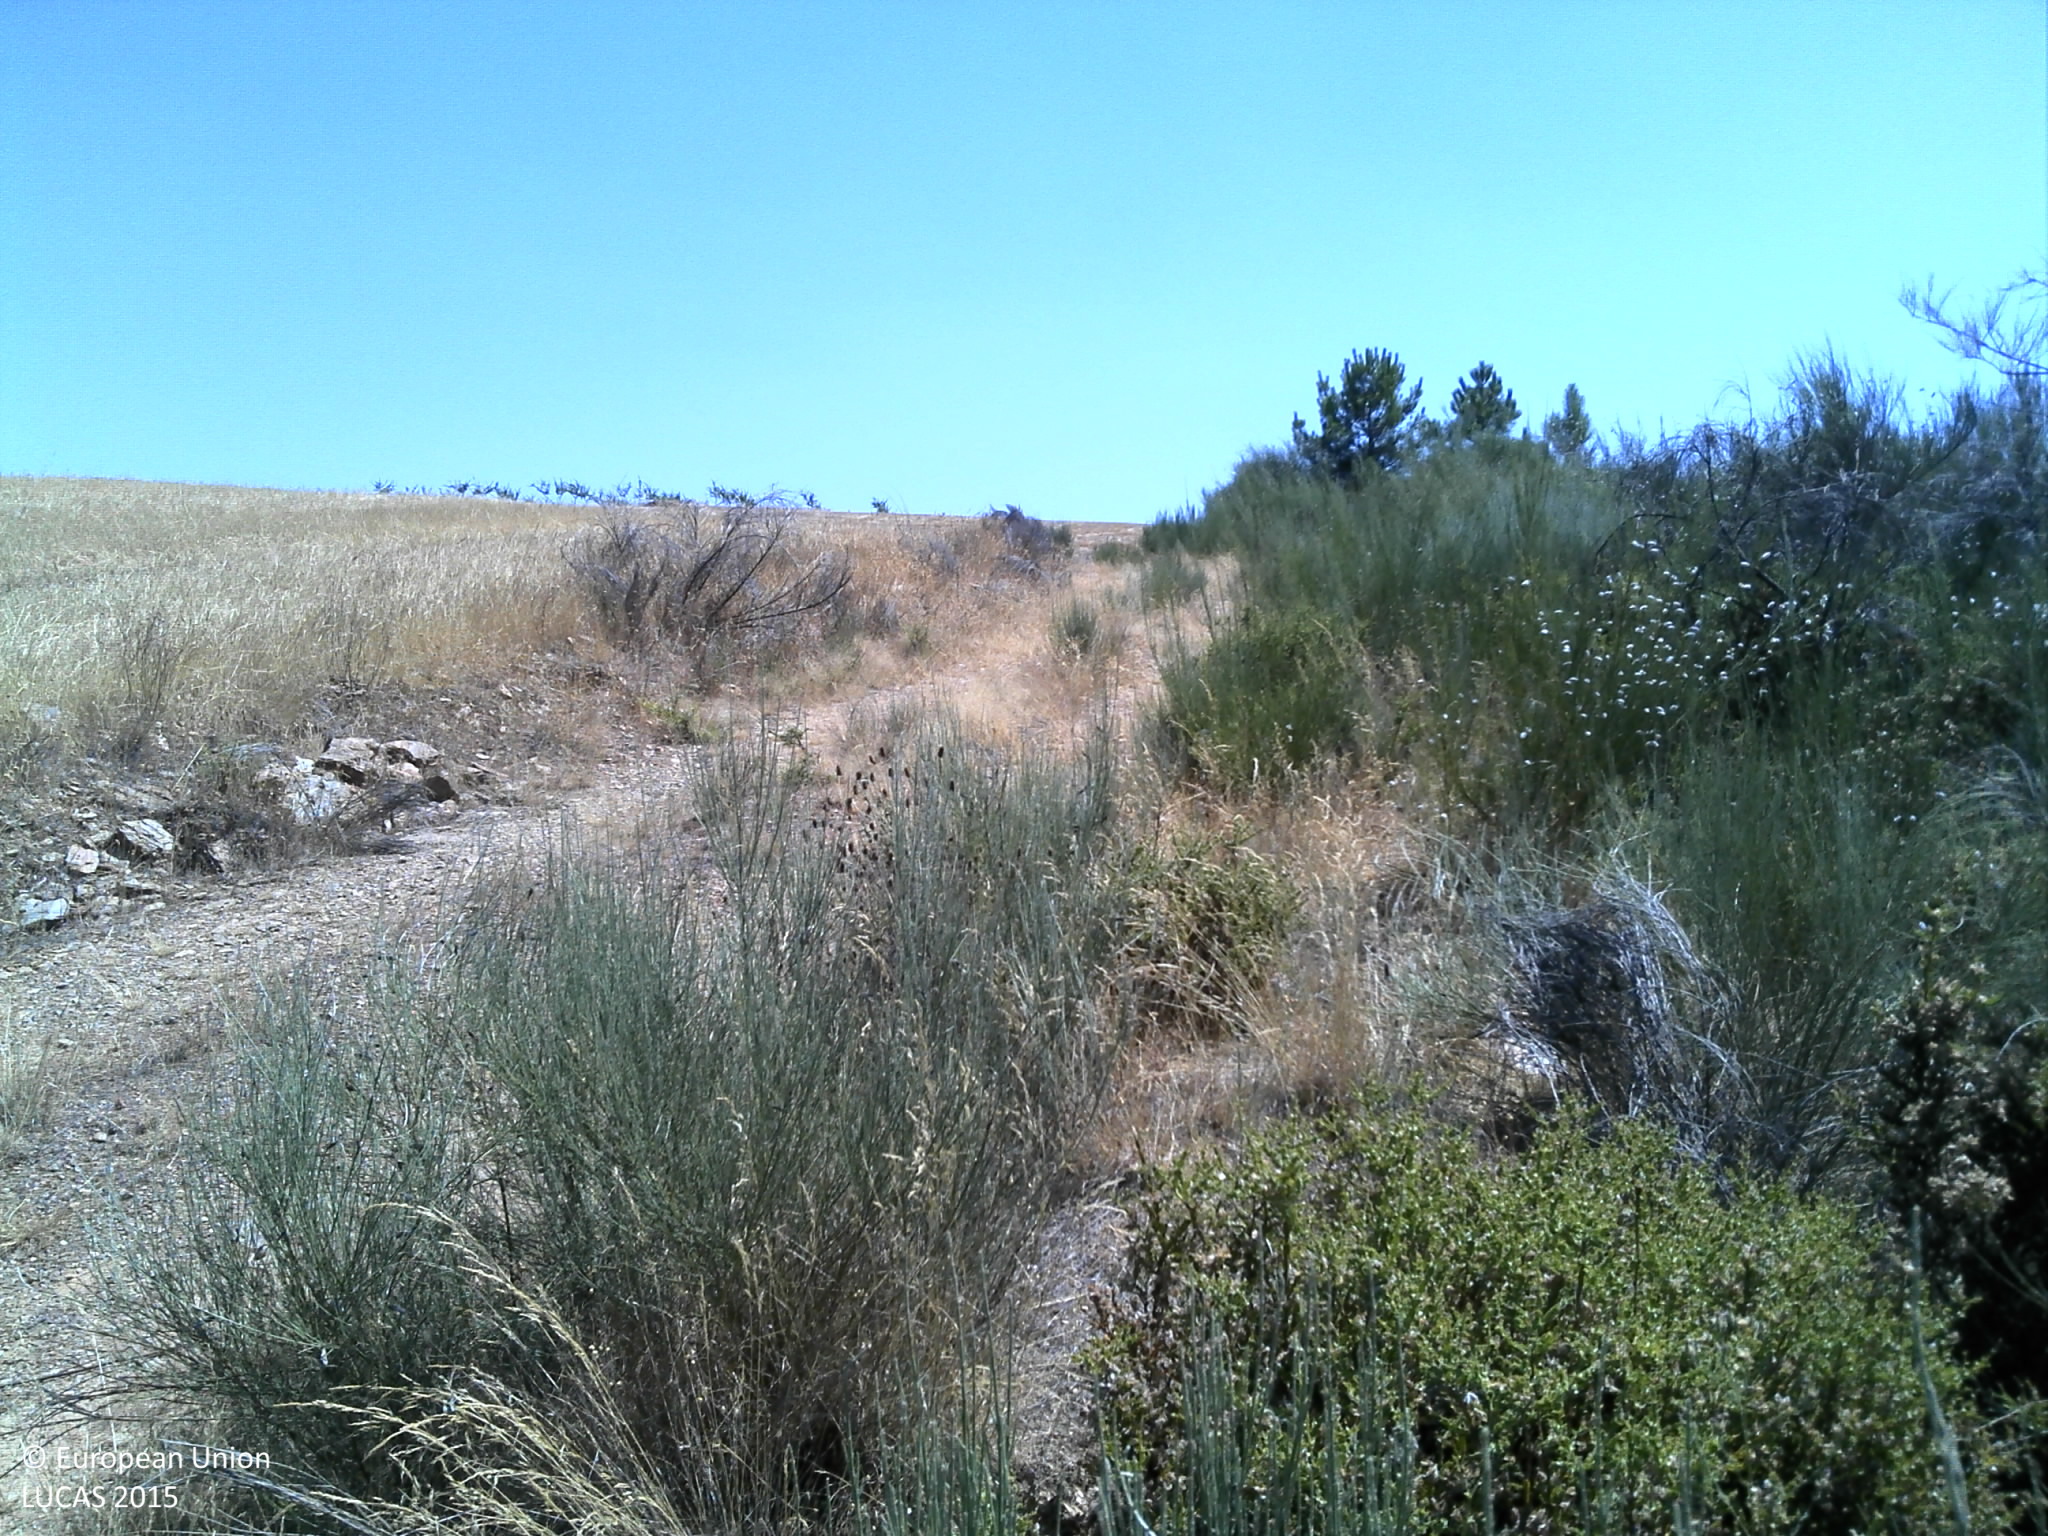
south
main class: Shrubland
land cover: Shrubland with sparse tree cover
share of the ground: > 75 %
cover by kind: shrubs 85 %, herbaceous plants 10 %, coniferous forest trees 5 %
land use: Abandoned areas
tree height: > 5 m
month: July
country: PT
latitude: 41.4730
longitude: -7.2560
